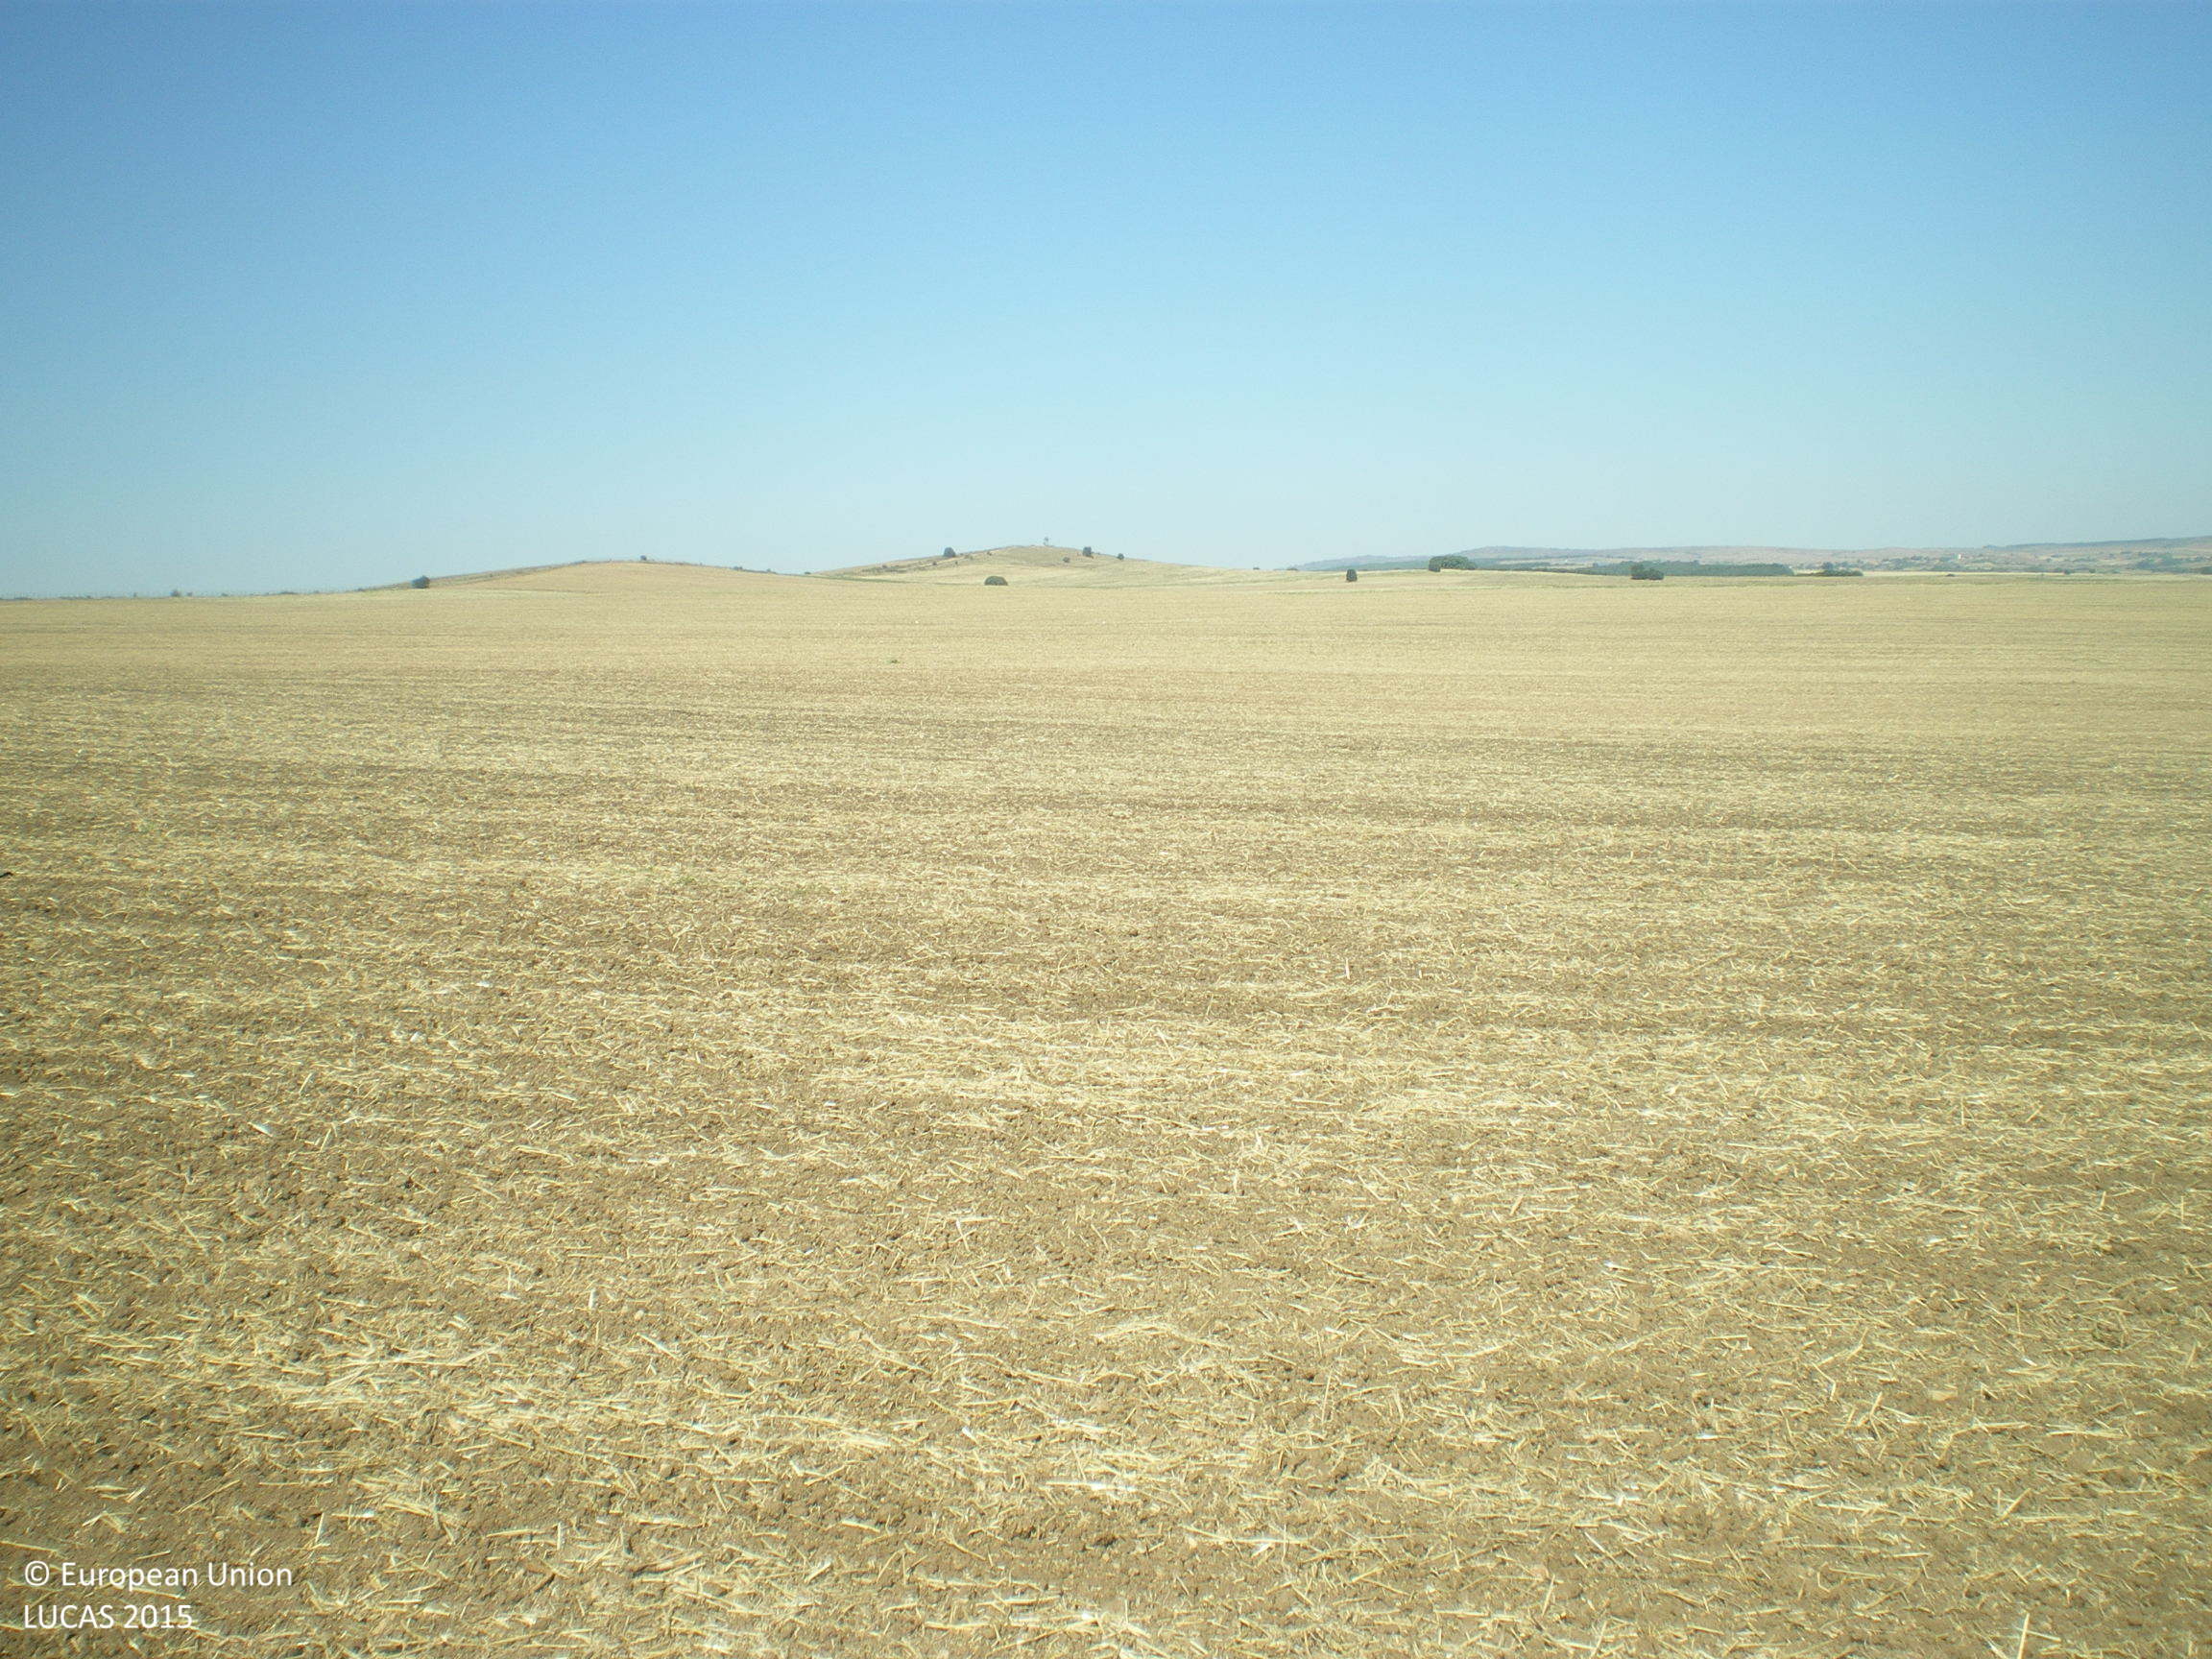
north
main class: Cropland
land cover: Common wheat
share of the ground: < 10 %
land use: Agriculture (excluding fallow land and kitchen gardens)
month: September
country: BG
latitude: 41.7775
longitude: 26.3327
